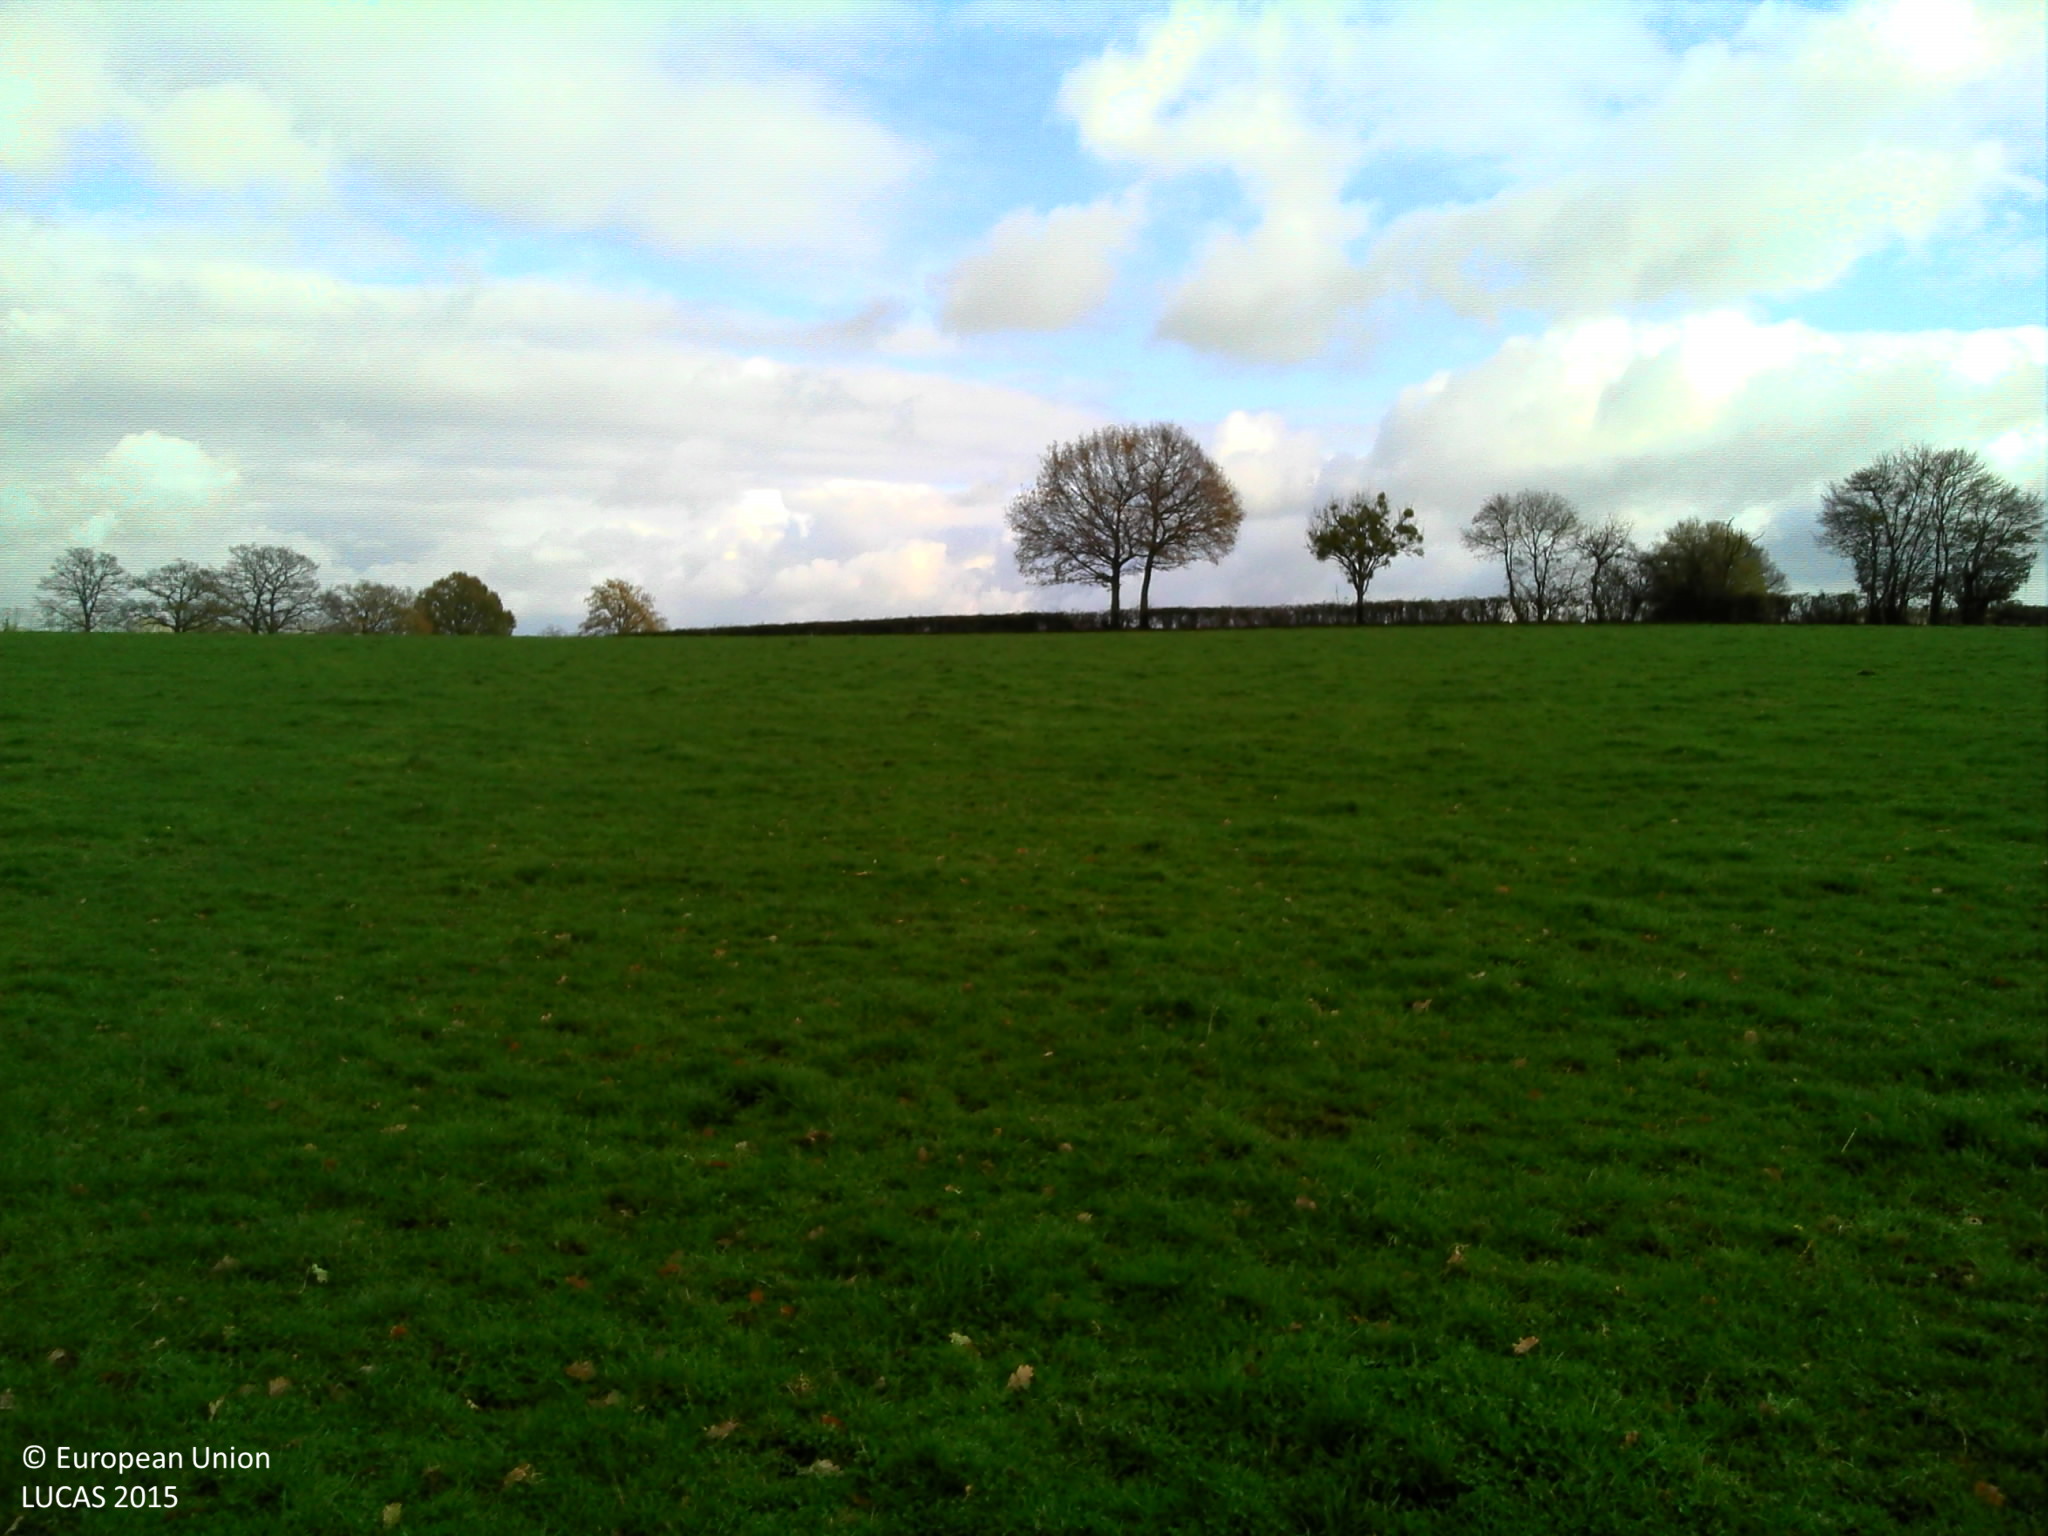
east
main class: Grassland
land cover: Grassland without tree/shrub cover
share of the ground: > 75 %
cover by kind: herbaceous plants 100 %
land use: Agriculture (excluding fallow land and kitchen gardens)
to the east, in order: Grassland without tree/shrub cover; Fences; Managed hedges; Fences; Grassland without tree/shrub cover; Fences; Grassland without tree/shrub cover
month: November
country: FR
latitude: 46.4177
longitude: 3.6895
